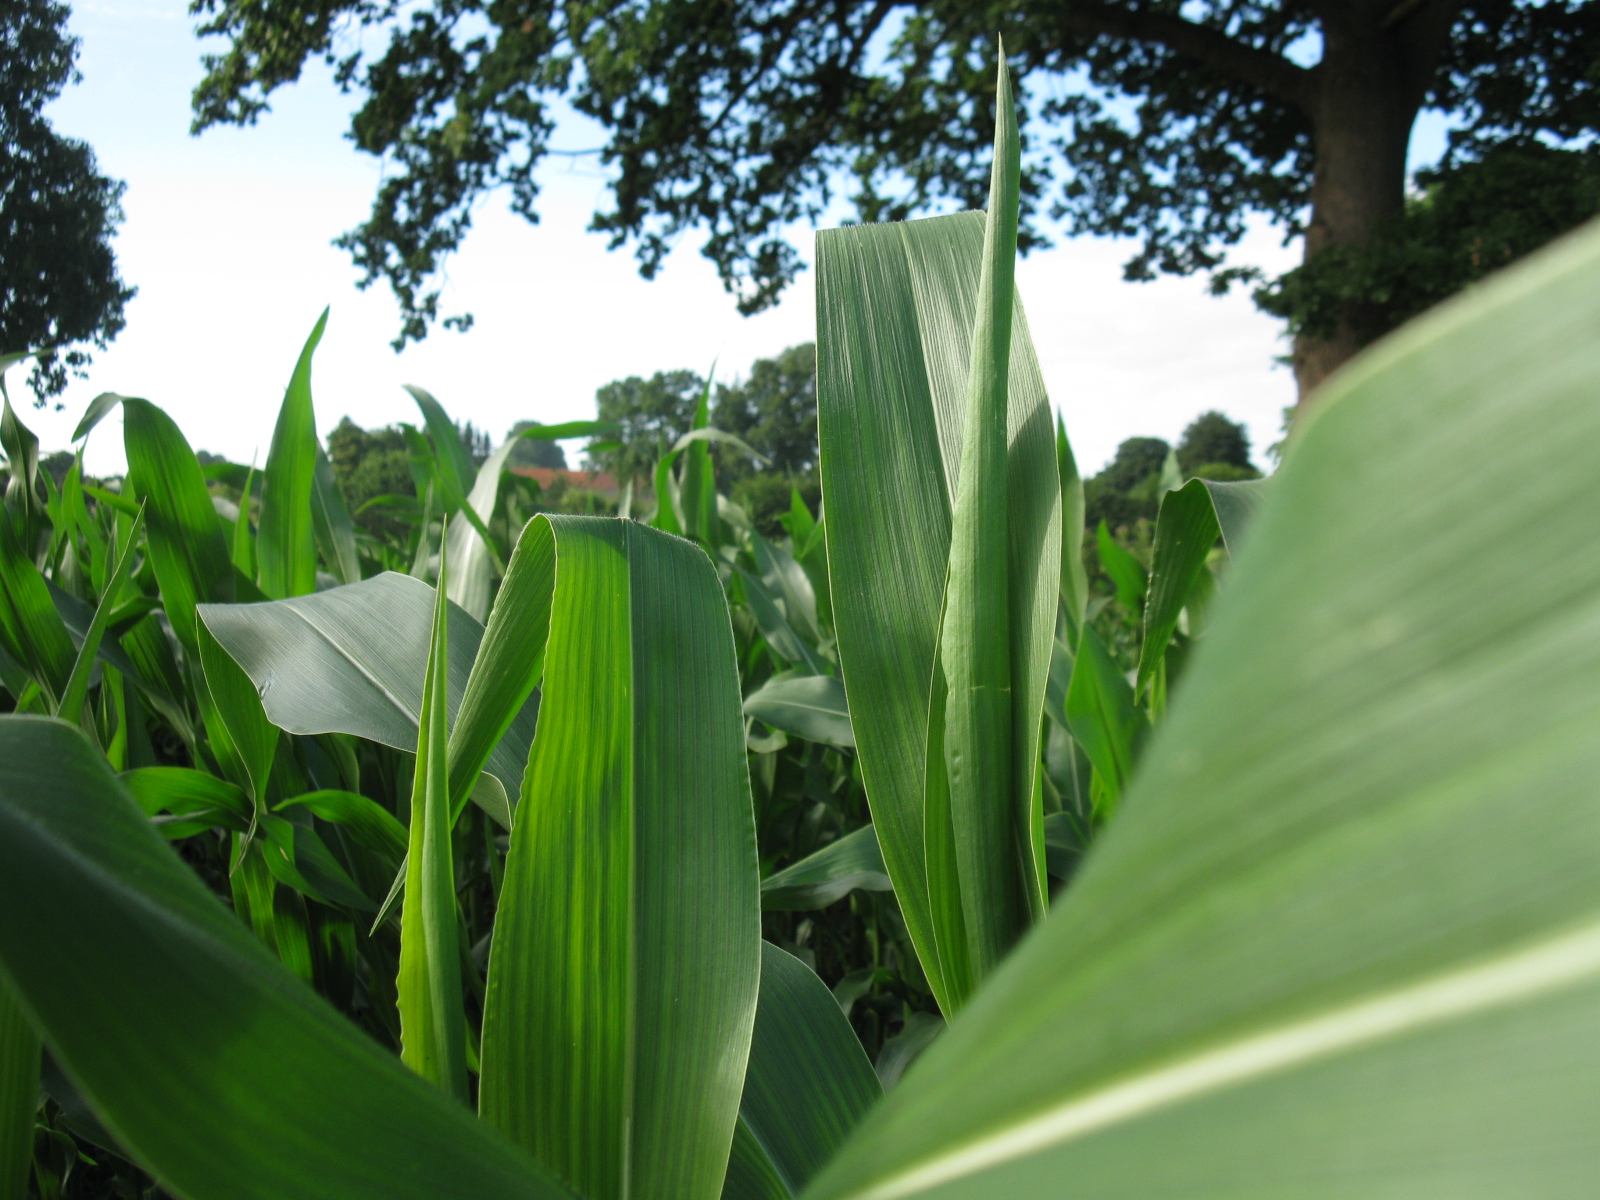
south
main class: Cropland
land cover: Maize
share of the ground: > 75 %
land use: Agriculture (excluding fallow land and kitchen gardens)
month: July
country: DE
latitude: 53.0873
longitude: 8.5224
